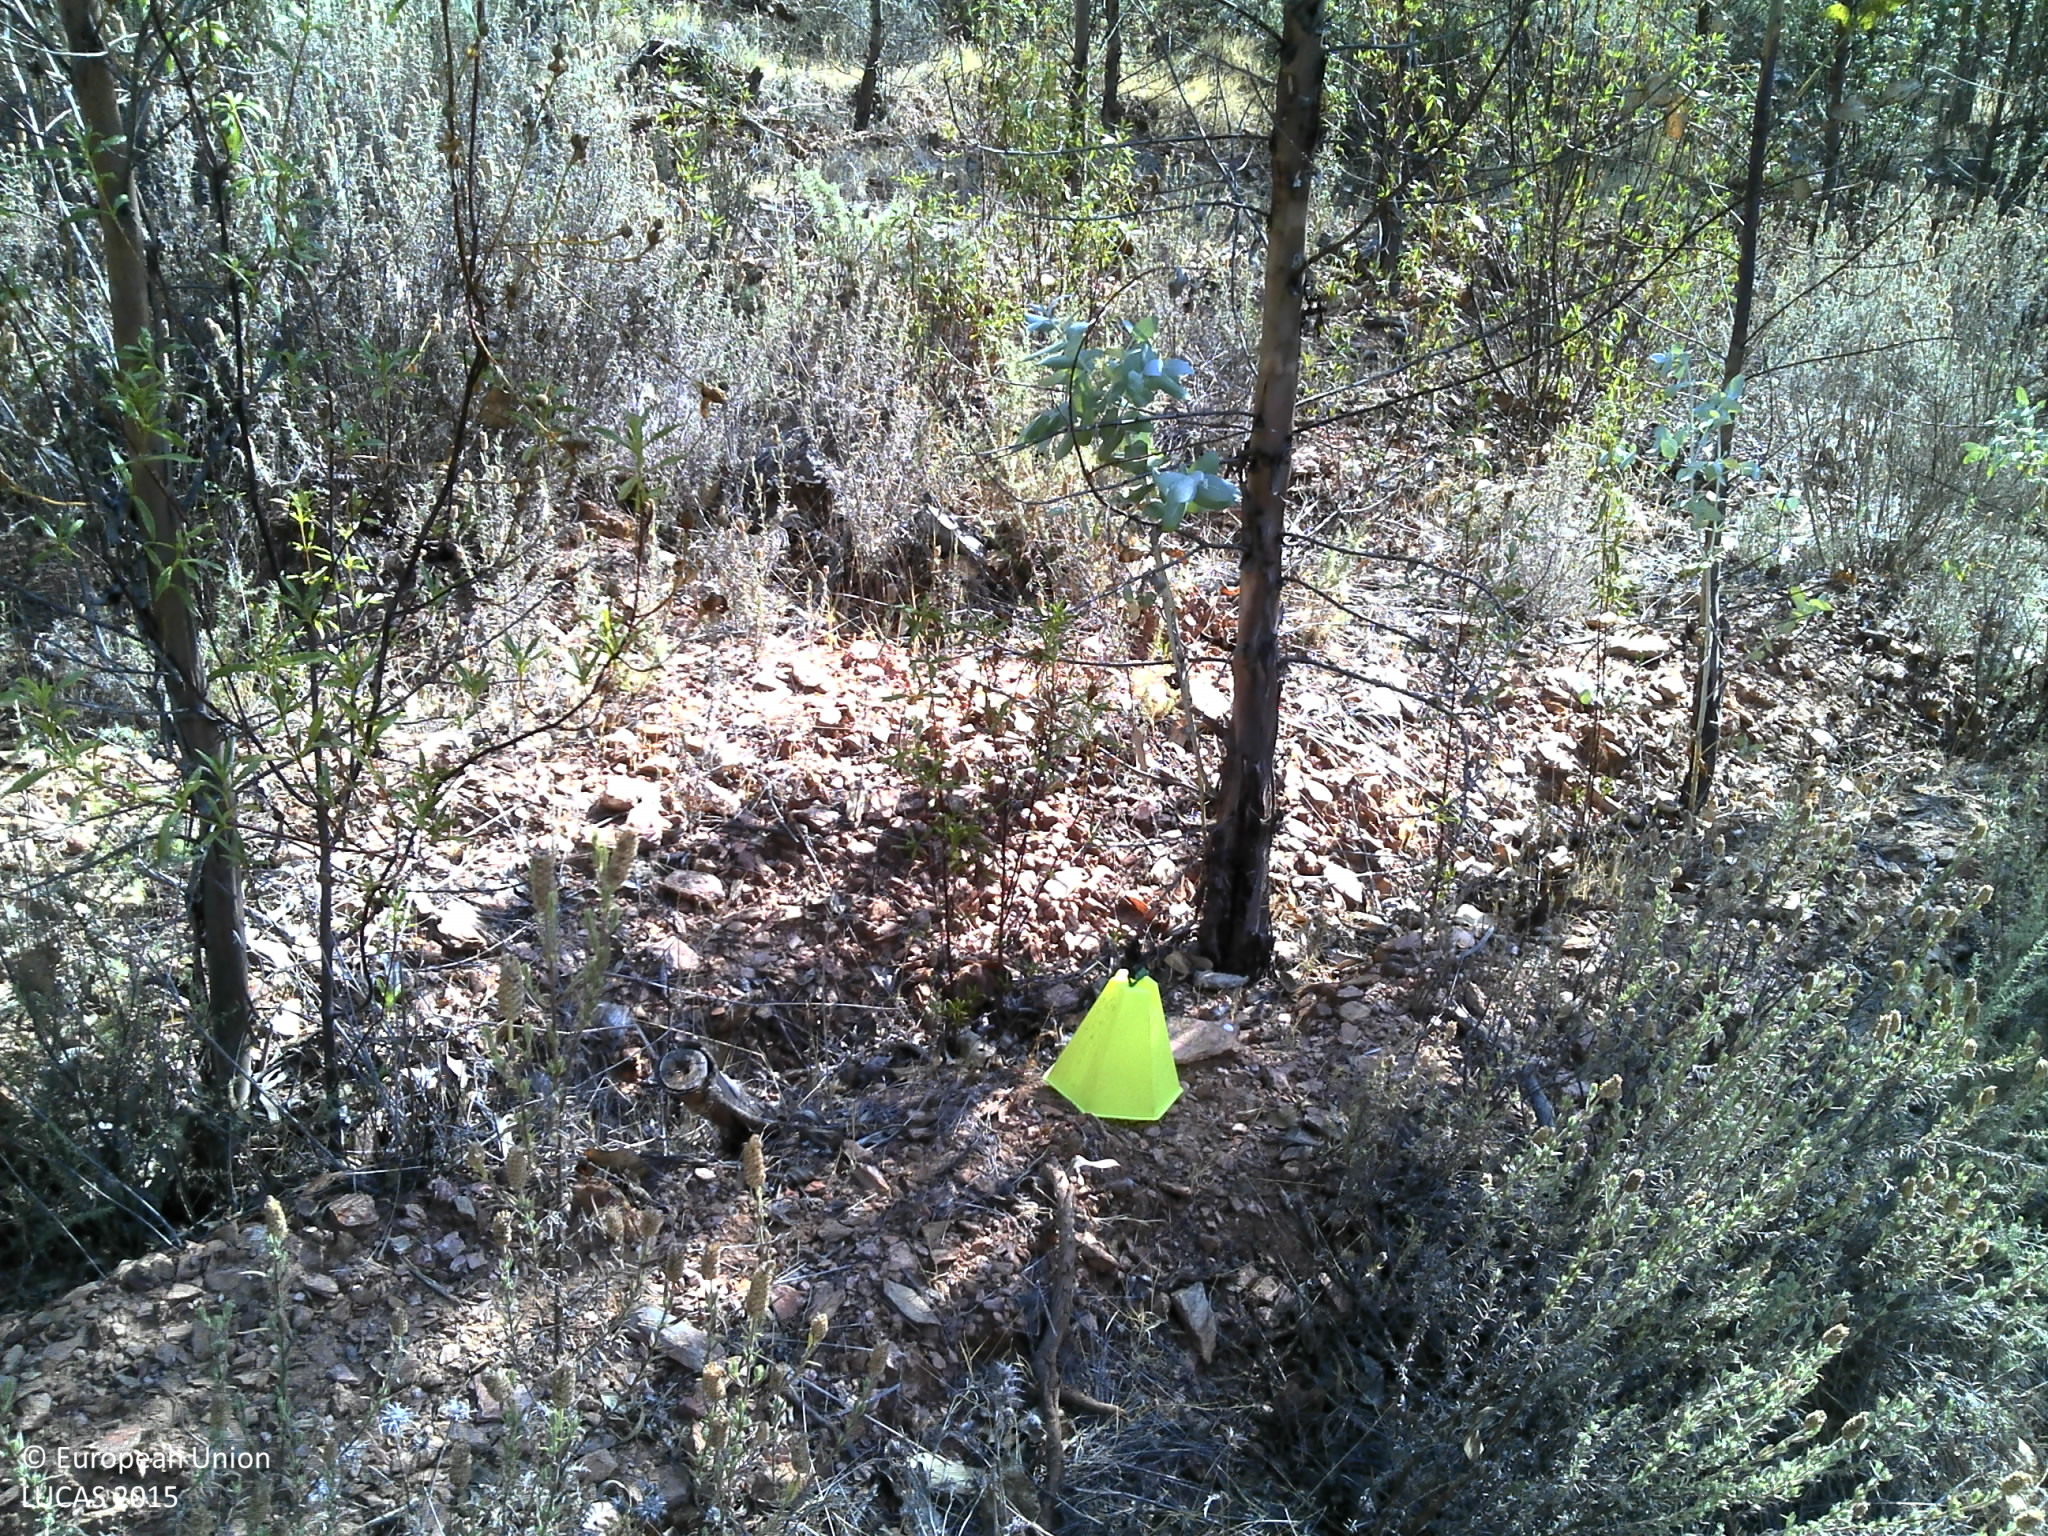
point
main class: Woodland
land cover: Broadleaved woodland
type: exotic forest
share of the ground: 25 - 50 %
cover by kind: broadleaved forest trees 40 %, shrubs 40 %, unconsolidated bare surface 20 %
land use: Forestry
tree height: > 5 m
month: July
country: PT
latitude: 38.6114
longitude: -7.4744
